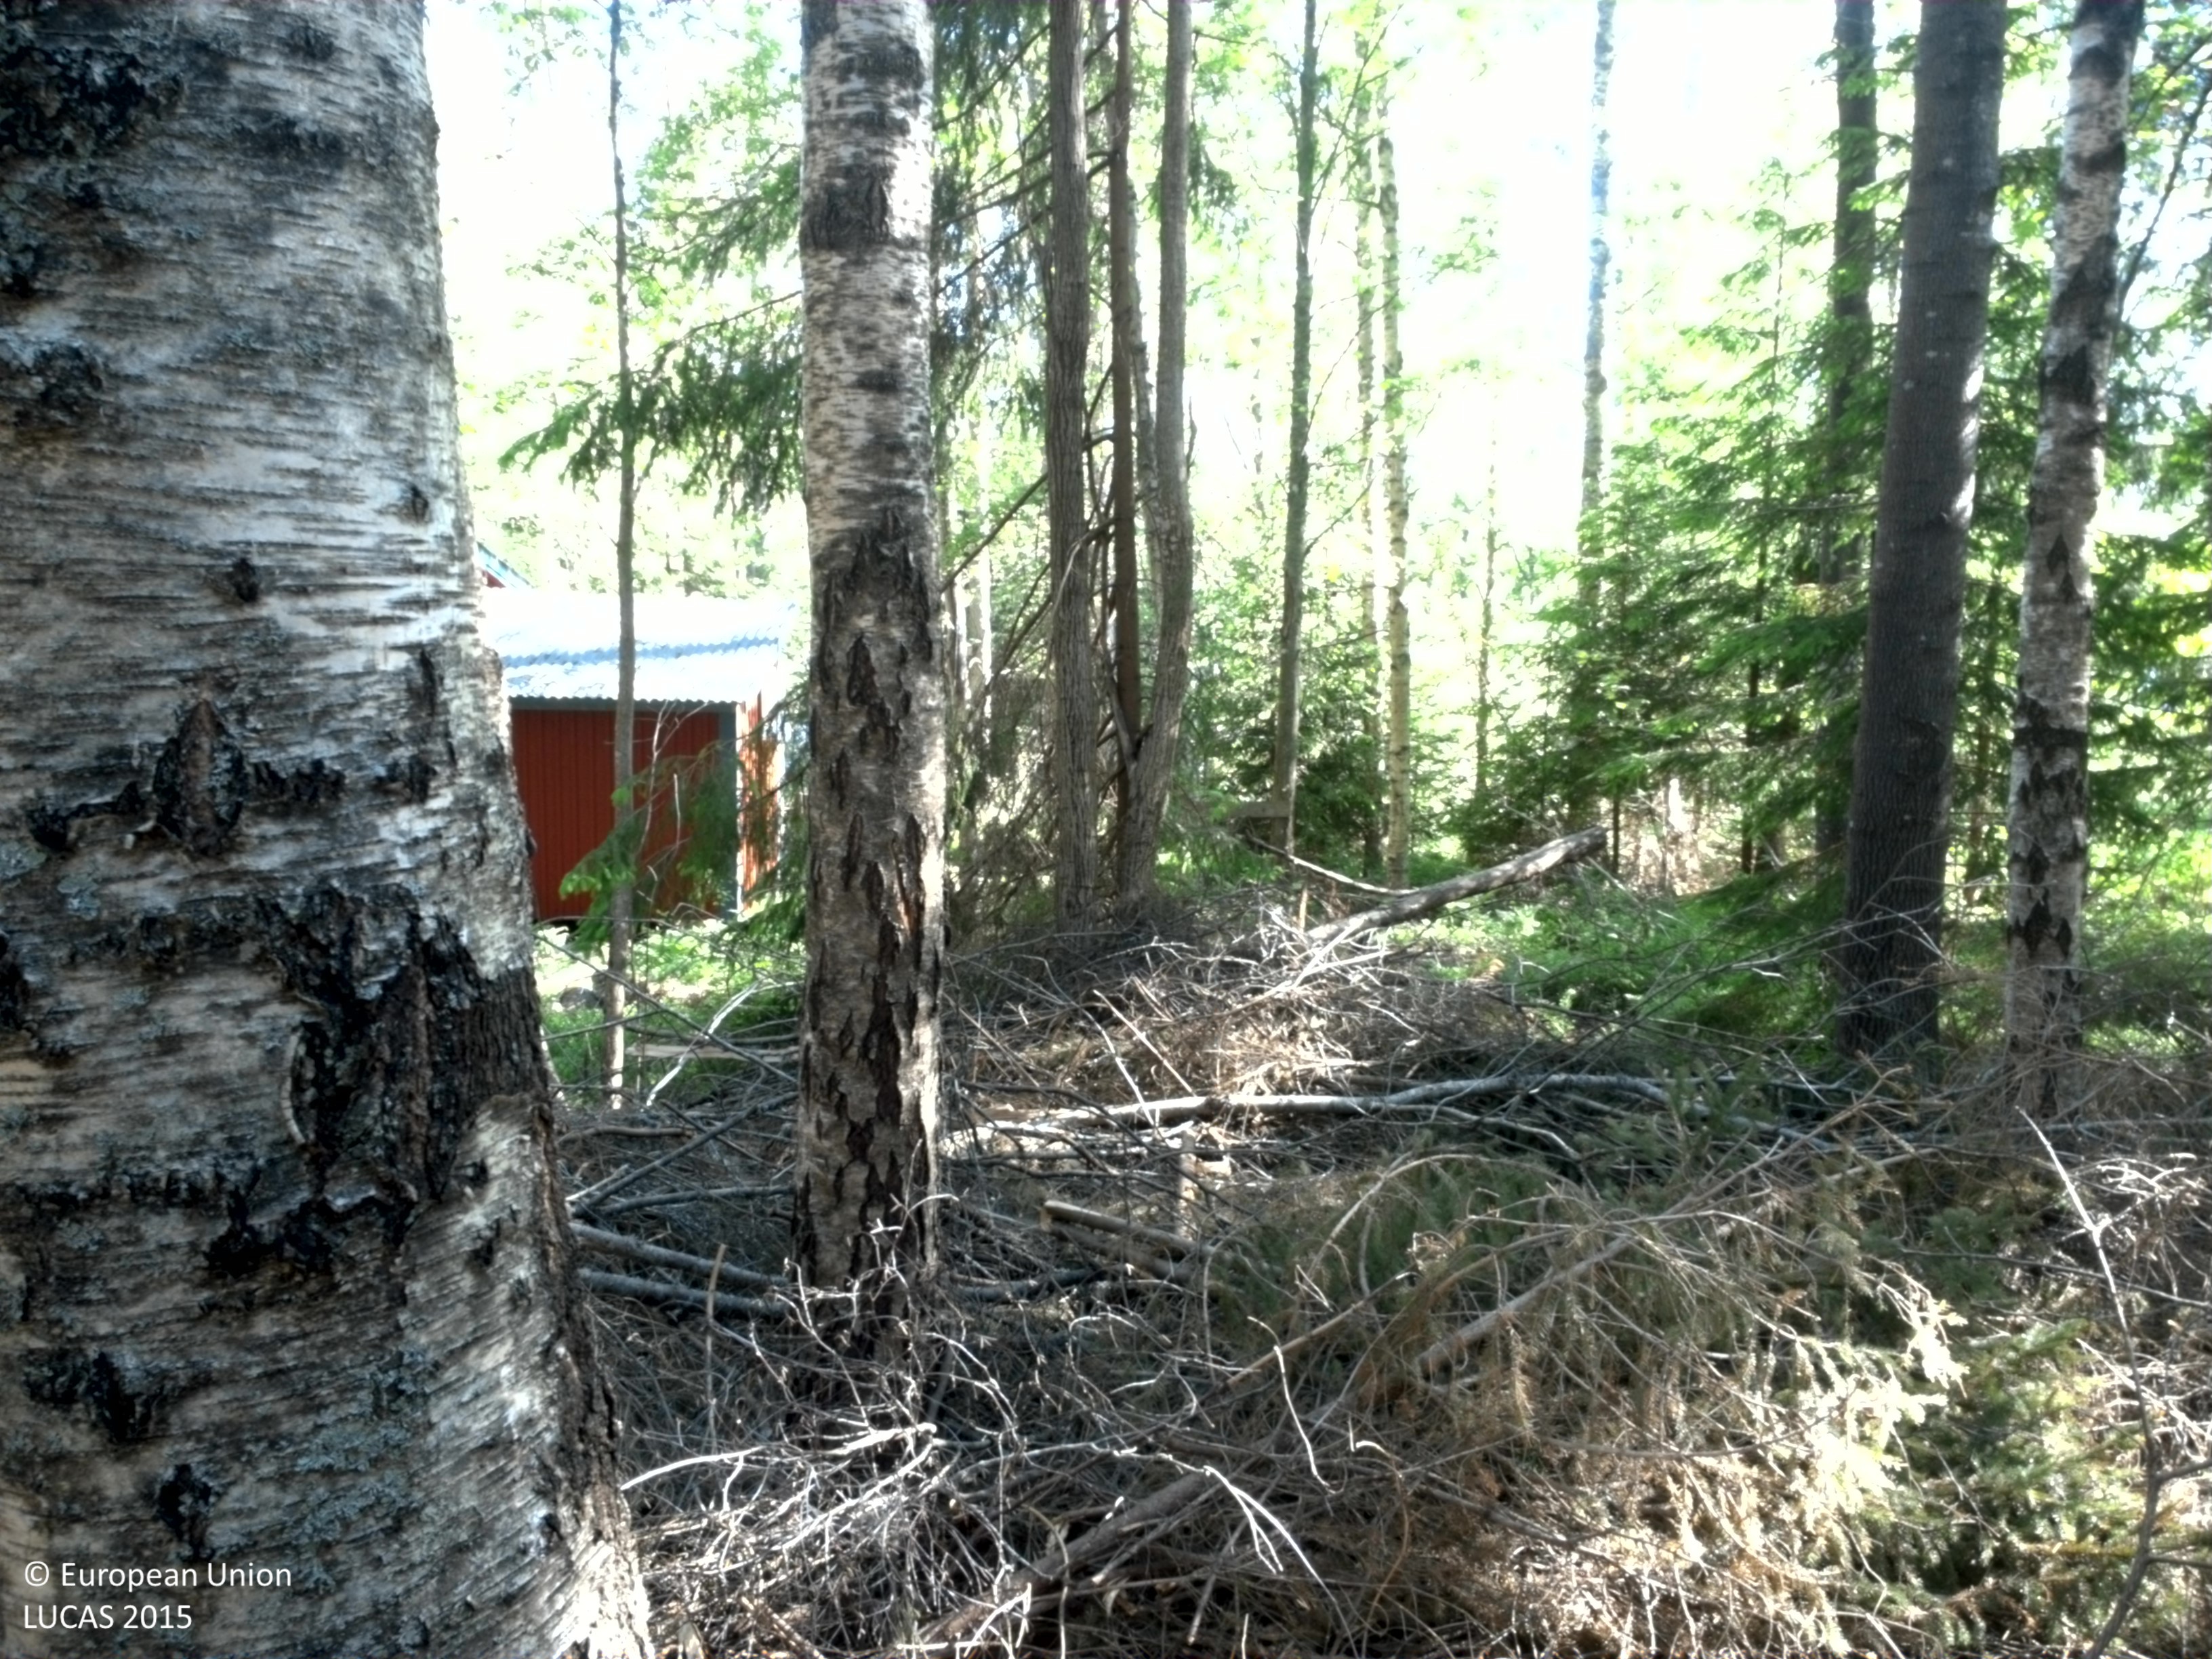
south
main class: Woodland
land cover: Spruce dominated mixed woodland
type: boreal forest
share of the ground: 50 - 75 %
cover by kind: coniferous forest trees 35 %, broadleaved forest trees 25 %, unconsolidated bare surface 15 %, shrubs 10 %, herbaceous plants 5 %
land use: Forestry
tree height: > 5 m
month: June
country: SE
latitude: 59.2928
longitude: 14.6440
